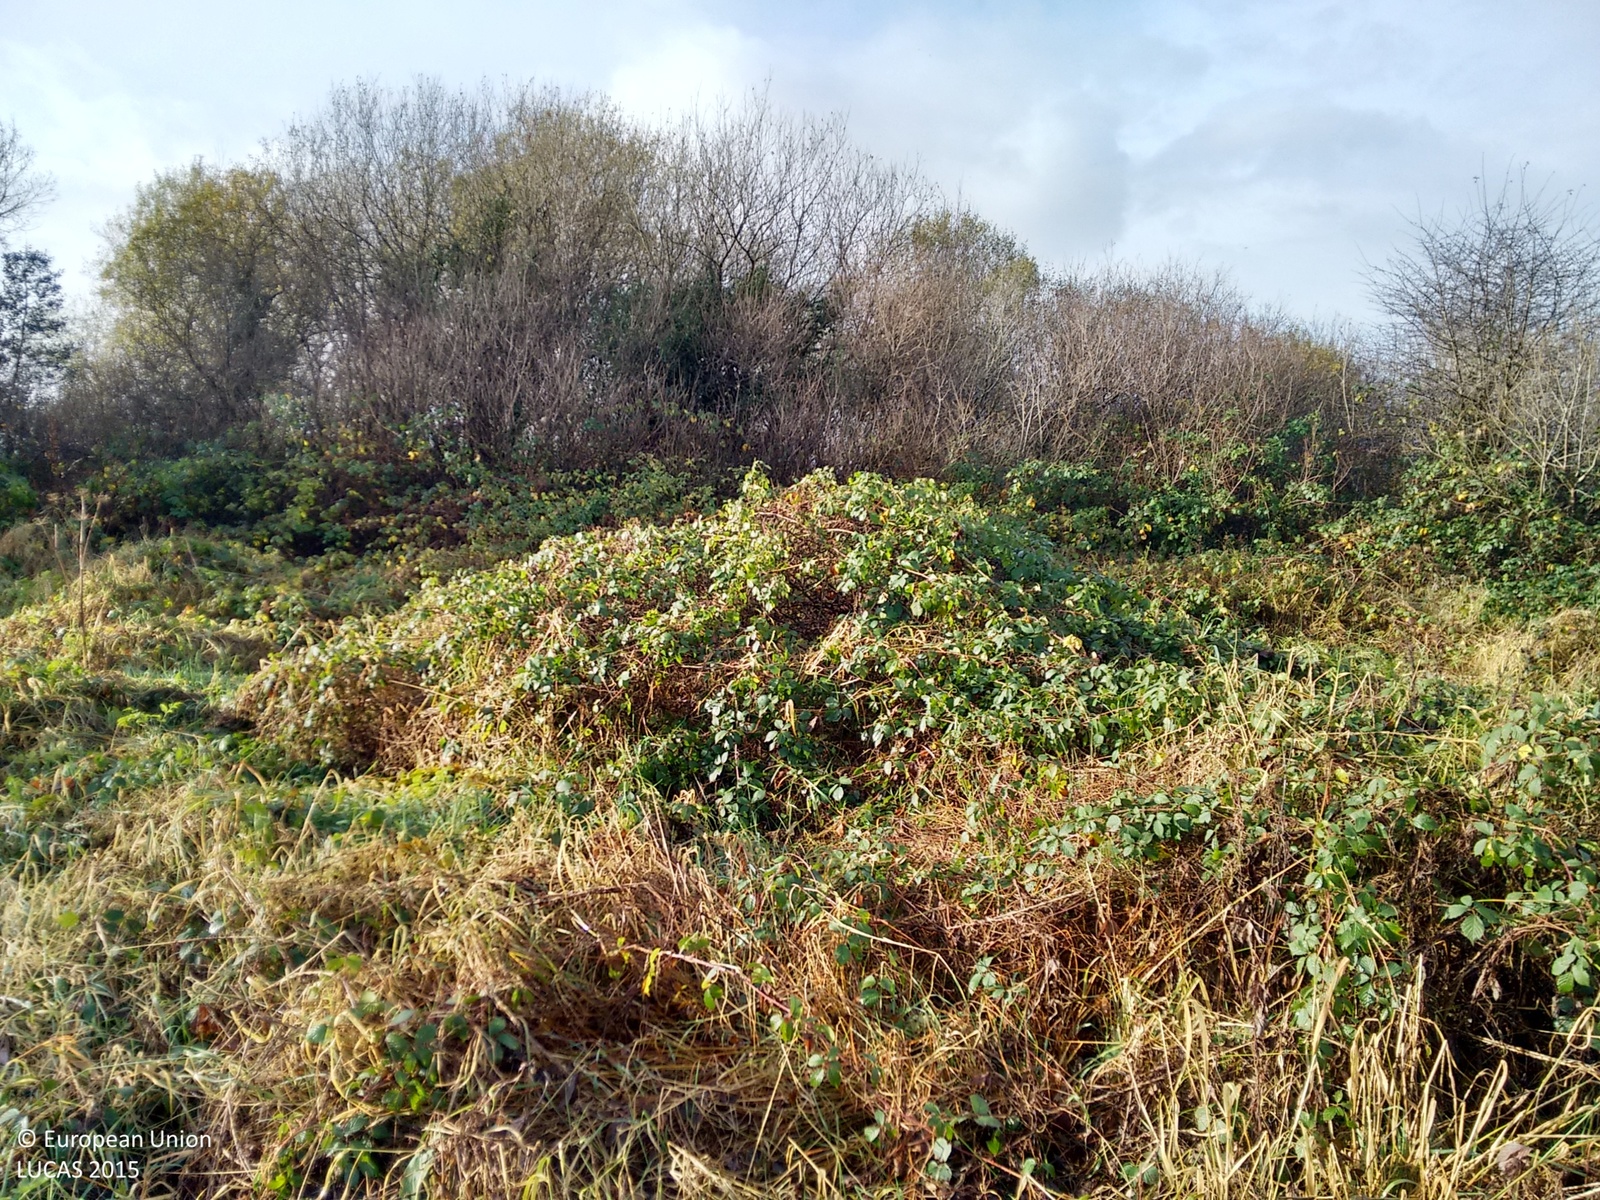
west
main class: Grassland
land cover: Spontaneously vegetated surfaces
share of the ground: > 75 %
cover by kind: herbaceous plants 95 %, shrubs 5 %
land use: Semi-natural and natural areas not in use
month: November
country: IE
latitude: 53.9793
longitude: -7.9676
